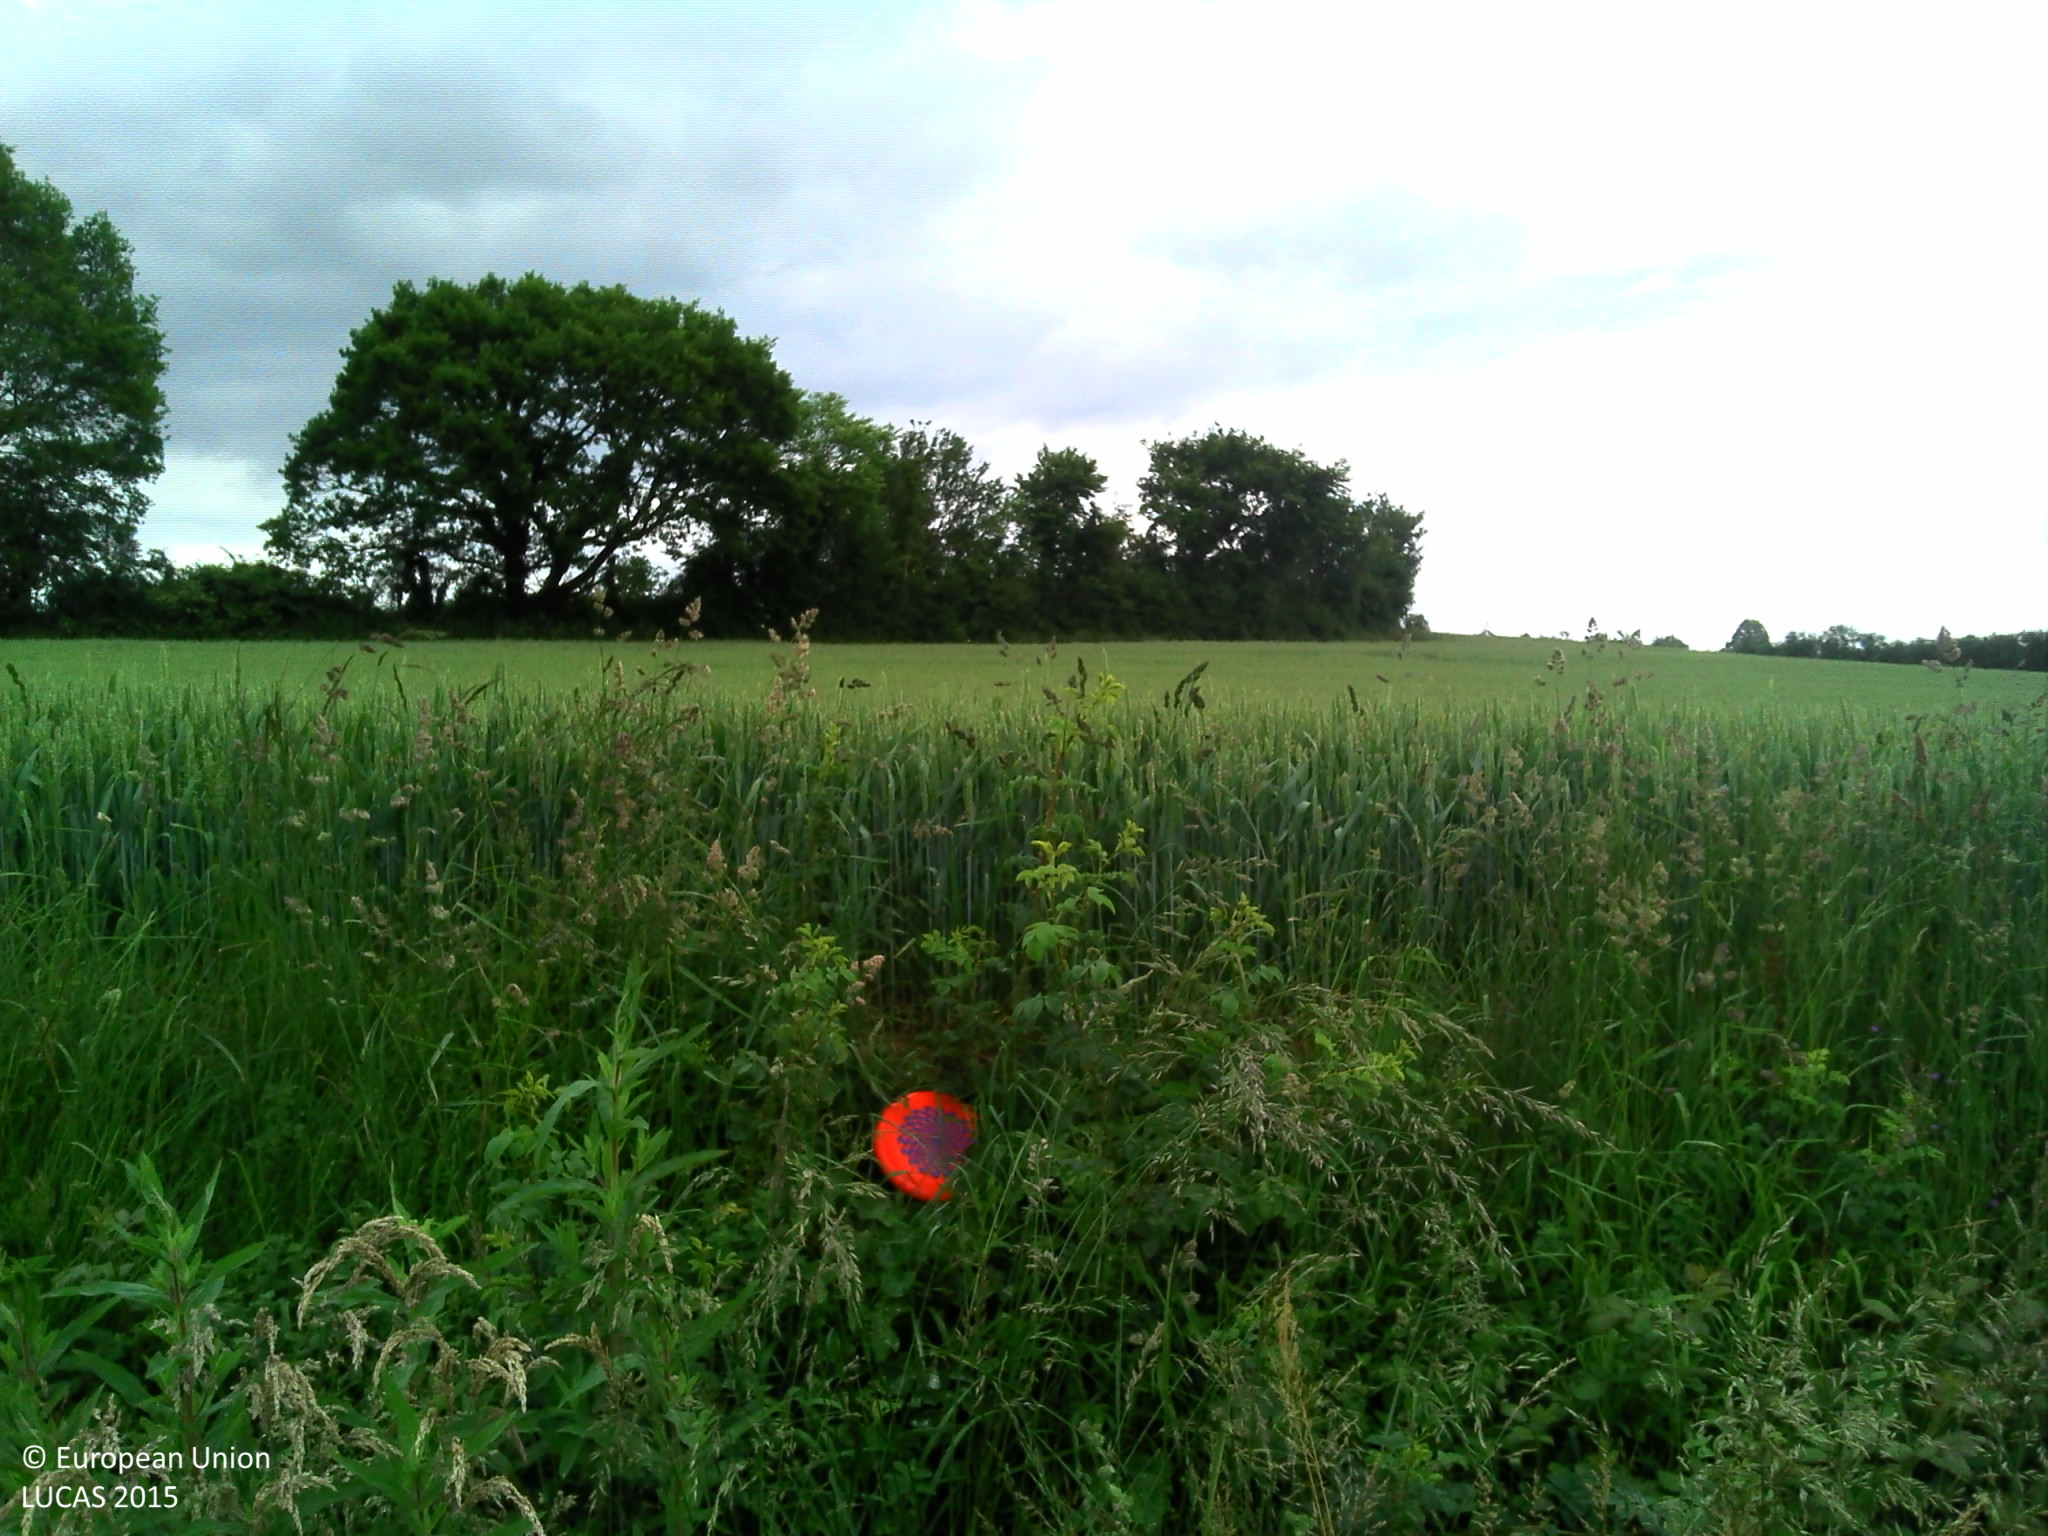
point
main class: Cropland
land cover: Common wheat
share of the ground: > 75 %
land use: Agriculture (excluding fallow land and kitchen gardens)
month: May
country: FR
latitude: 48.0305
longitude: -0.1003
